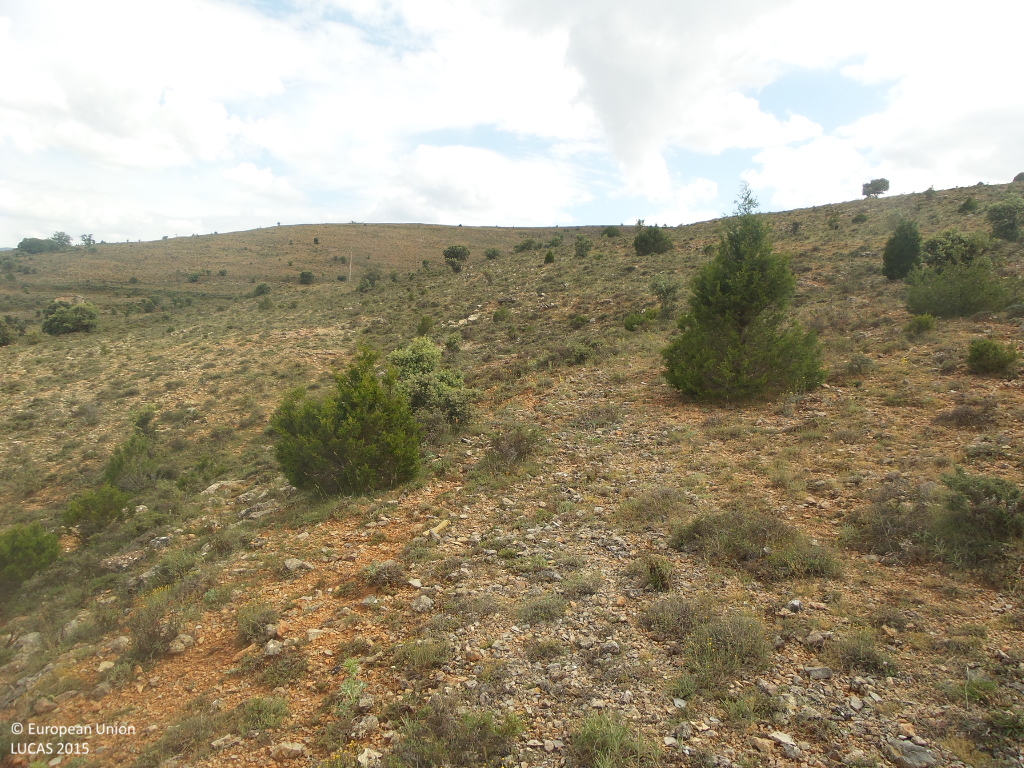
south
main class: Shrubland
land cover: Shrubland with sparse tree cover
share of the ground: 25 - 50 %
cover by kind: shrubs 45 %, unconsolidated bare surface 30 %, consolidated bare surface 20 %, broadleaved forest trees 5 %
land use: Semi-natural and natural areas not in use
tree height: < 5 m
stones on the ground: 25 - 50 %
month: June
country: ES
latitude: 41.3565
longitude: -3.1302
